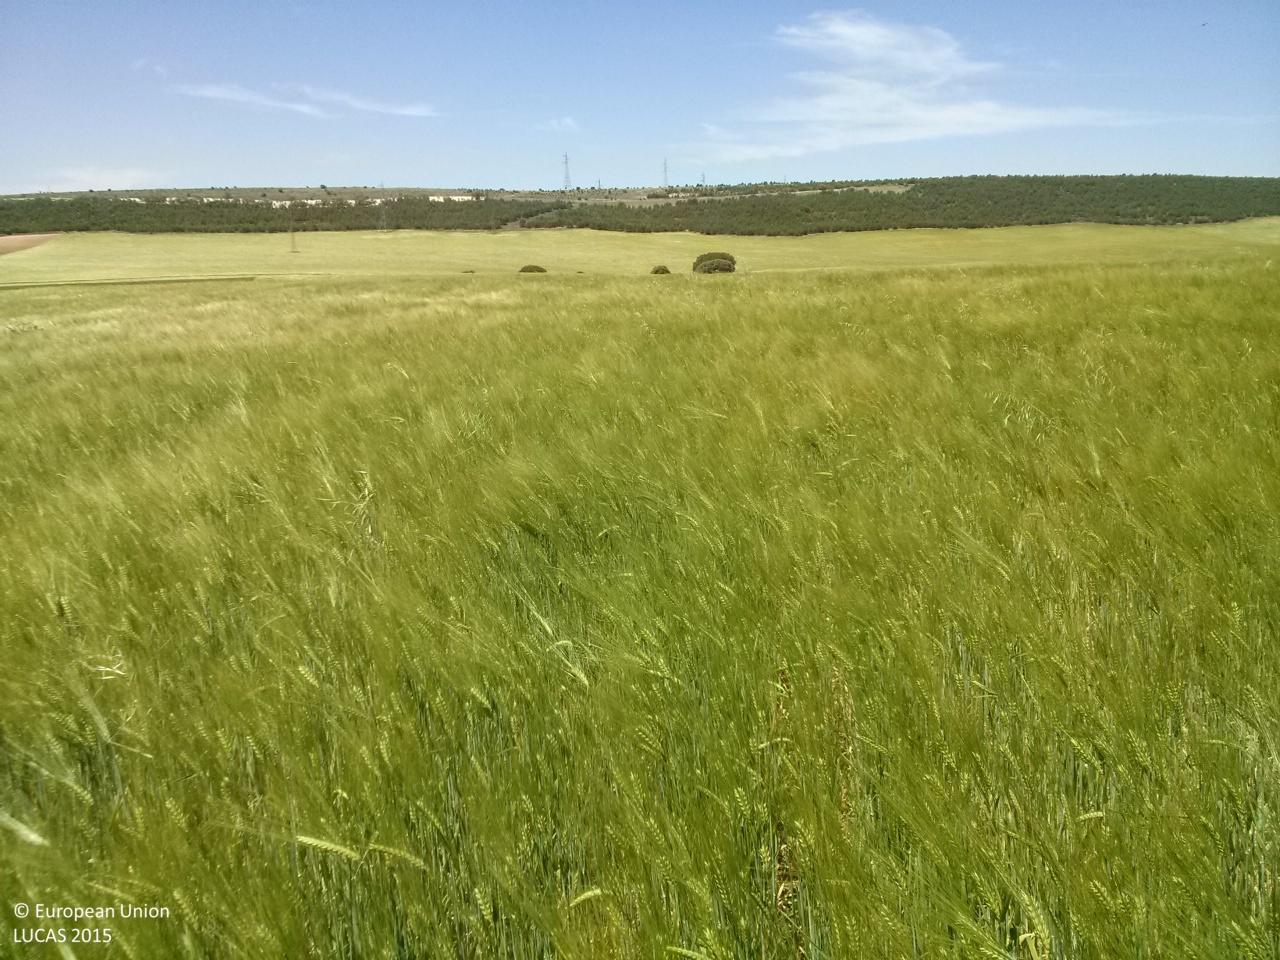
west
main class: Cropland
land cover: Barley
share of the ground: > 75 %
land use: Agriculture (excluding fallow land and kitchen gardens)
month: May
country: ES
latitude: 40.0219
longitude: -2.8524
